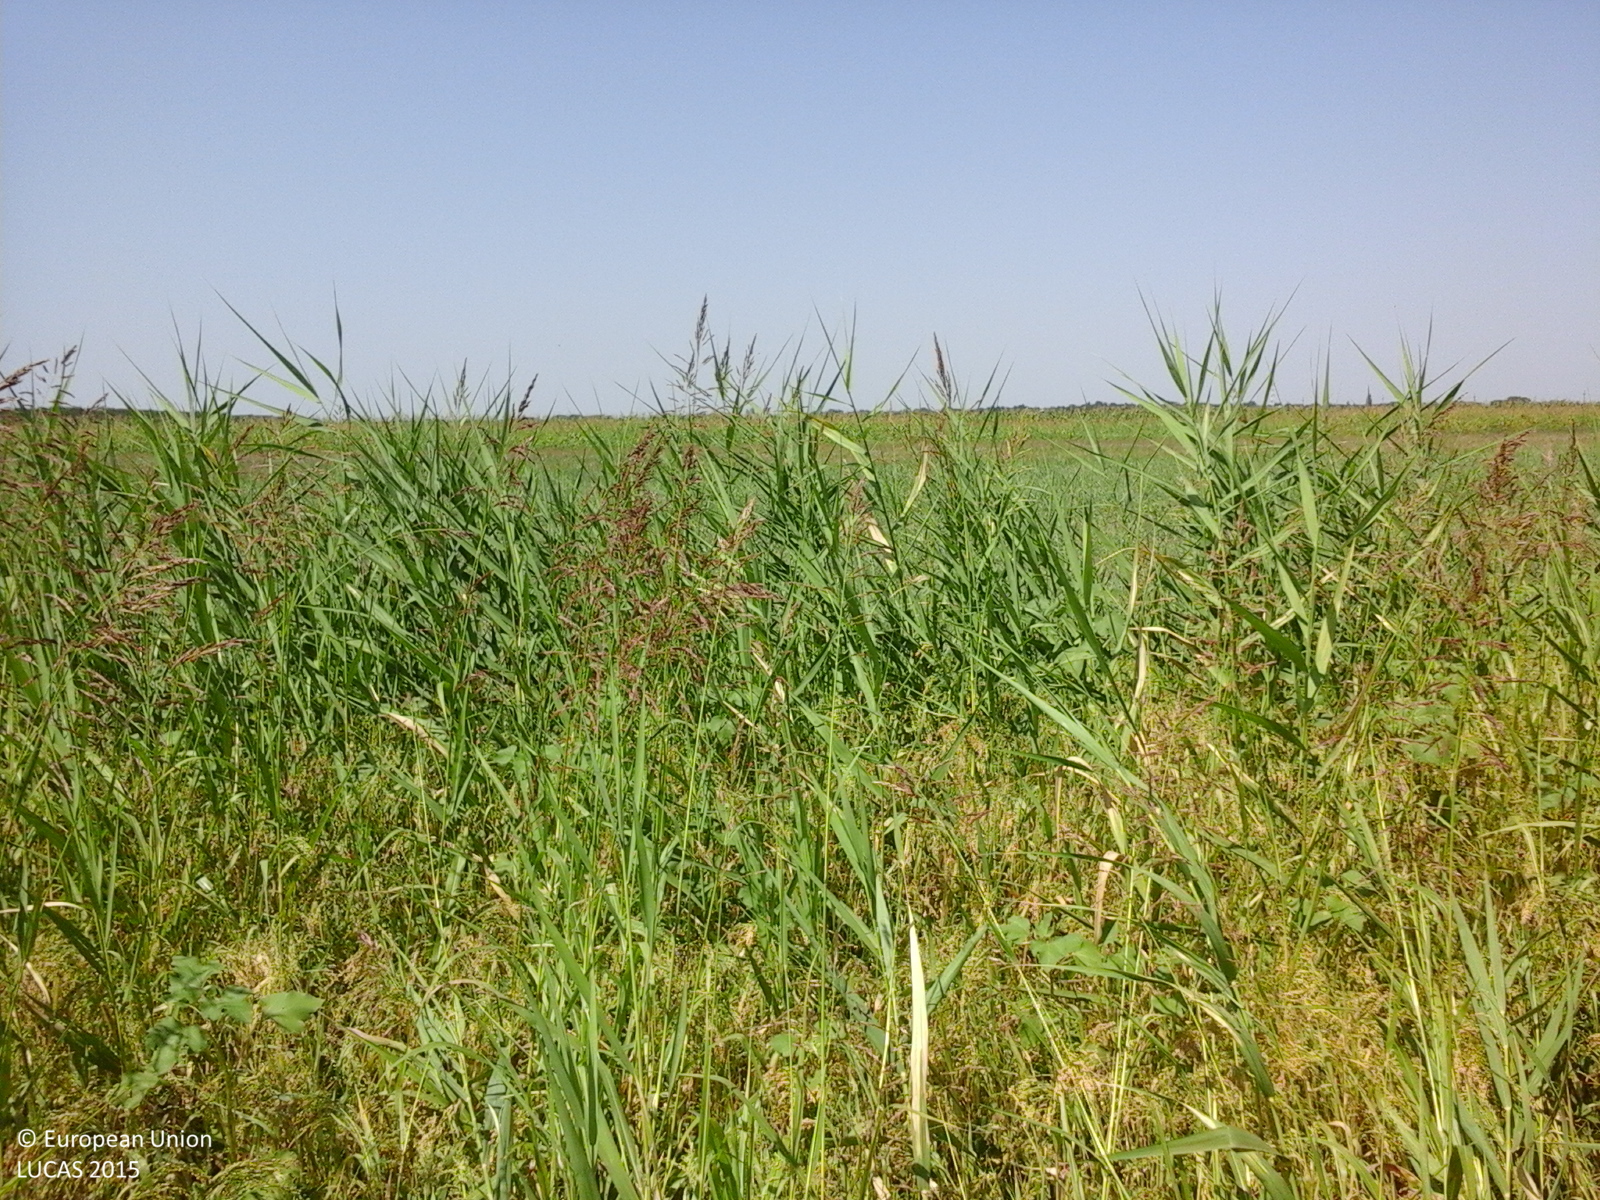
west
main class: Grassland
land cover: Spontaneously vegetated surfaces
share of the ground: > 75 %
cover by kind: herbaceous plants 100 %
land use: Fallow land
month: July
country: RO
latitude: 45.0383
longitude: 27.1883
